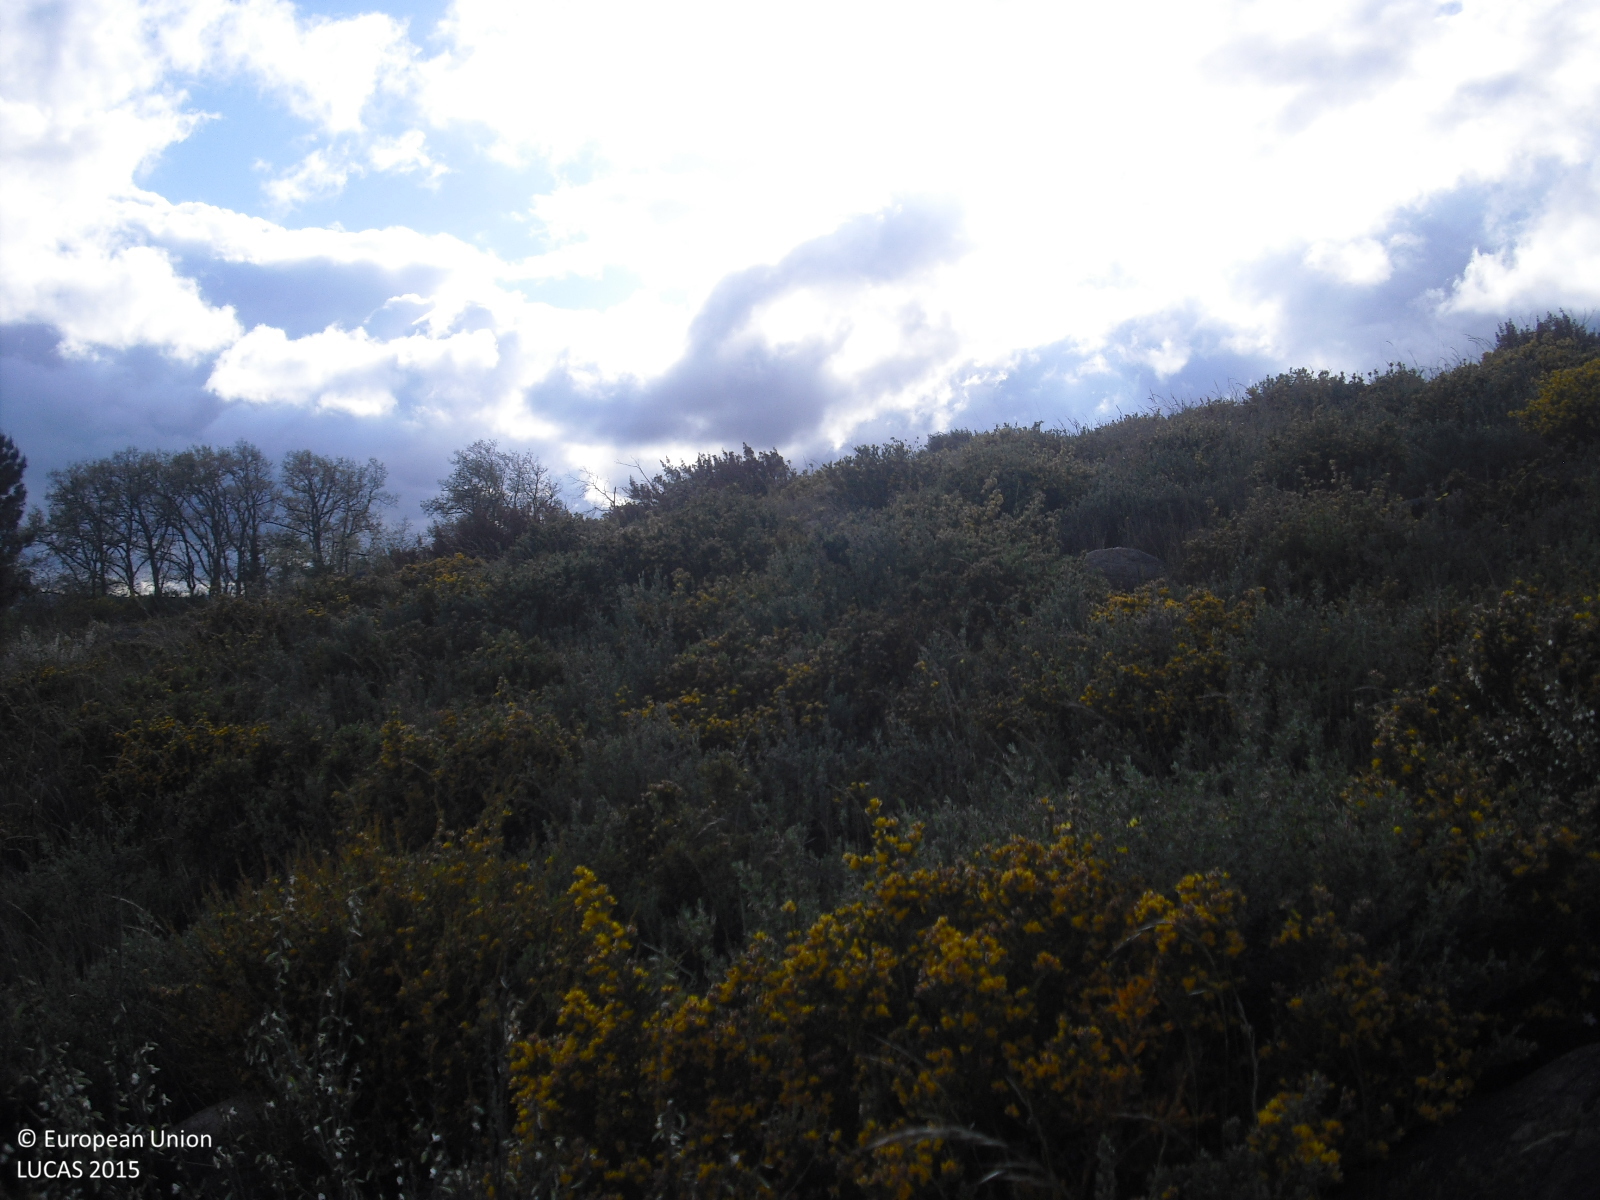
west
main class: Shrubland
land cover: Shrubland without tree cover
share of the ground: > 75 %
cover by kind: shrubs 85 %, consolidated bare surface 15 %
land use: Semi-natural and natural areas not in use
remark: Burnt area
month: April
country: ES
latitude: 41.8515
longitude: -7.5137
